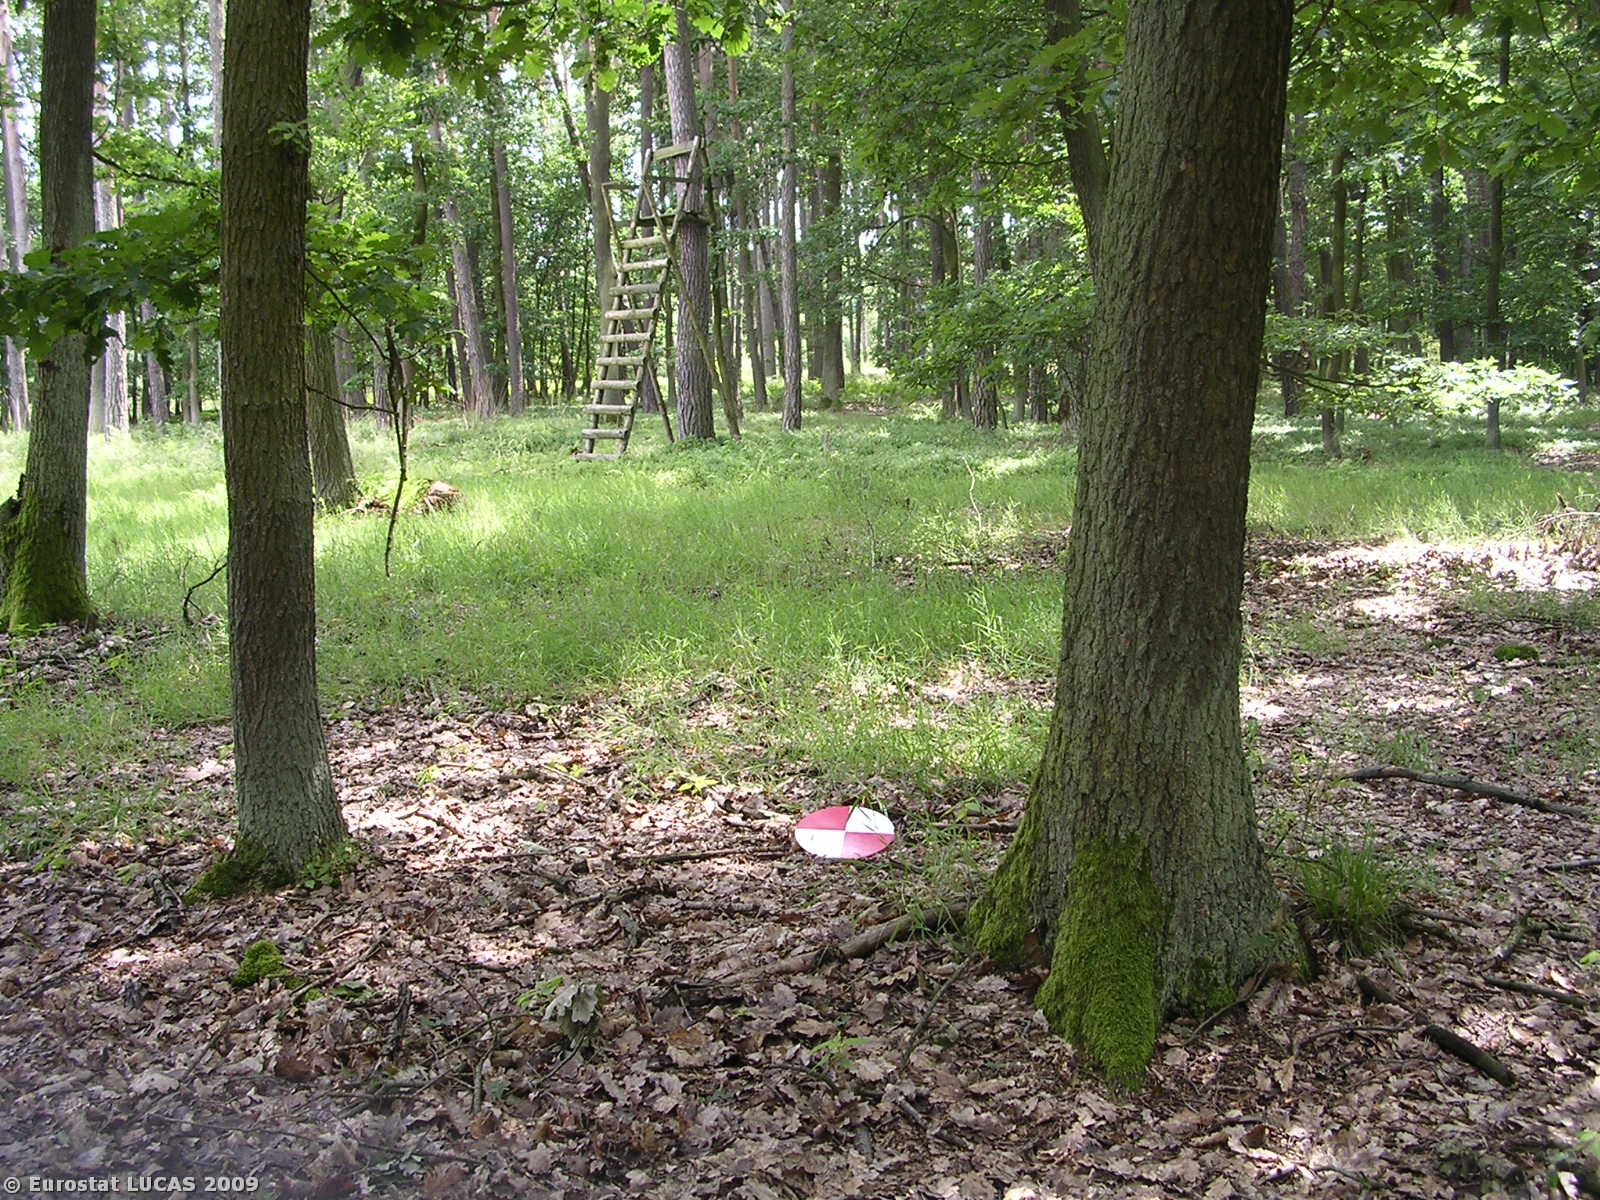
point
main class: Woodland
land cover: Broadleaved woodland
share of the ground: > 75 %
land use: Forestry
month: June
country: CZ
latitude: 50.4768
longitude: 14.8641
